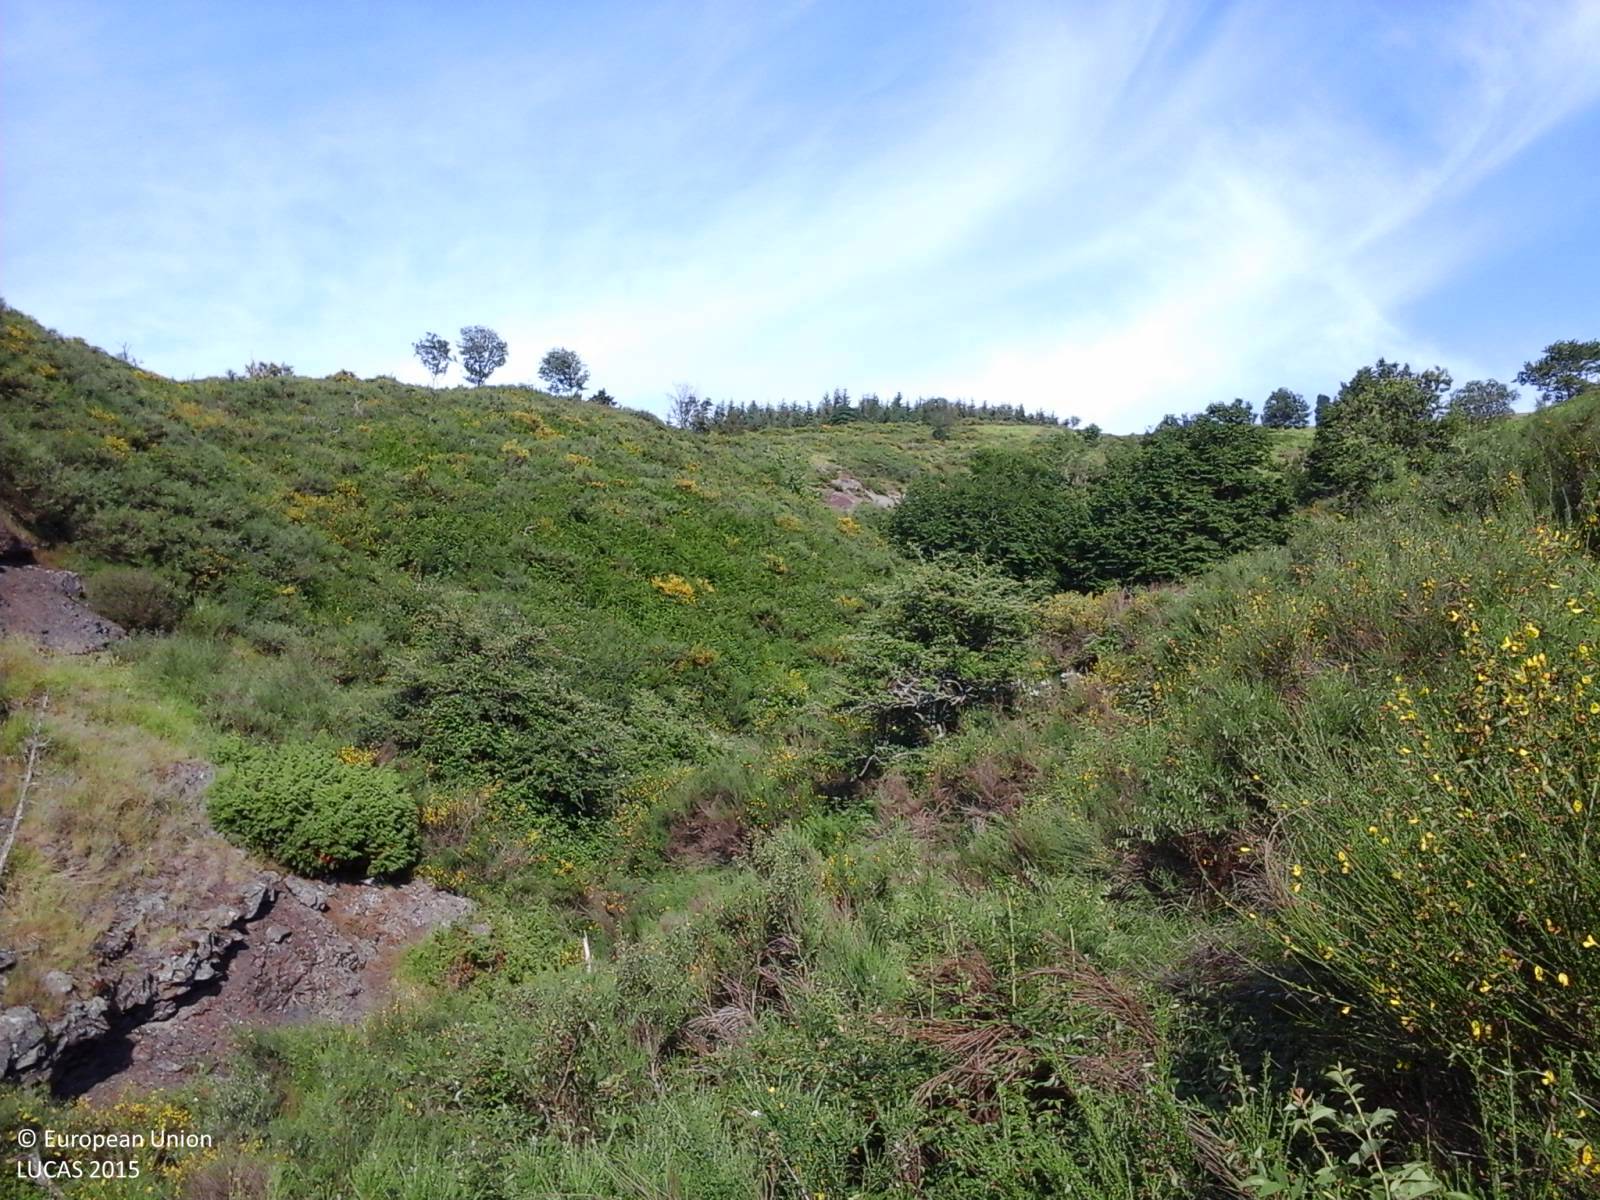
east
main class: Shrubland
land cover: Shrubland without tree cover
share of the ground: > 75 %
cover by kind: shrubs 50 %, herbaceous plants 30 %, consolidated bare surface 20 %
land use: Semi-natural and natural areas not in use
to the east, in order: Shrubland without tree cover; Shrubland with sparse tree cover; Shrubland without tree cover; Shrubland with sparse tree cover
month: June
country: IT
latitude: 44.0601
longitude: 10.6102
